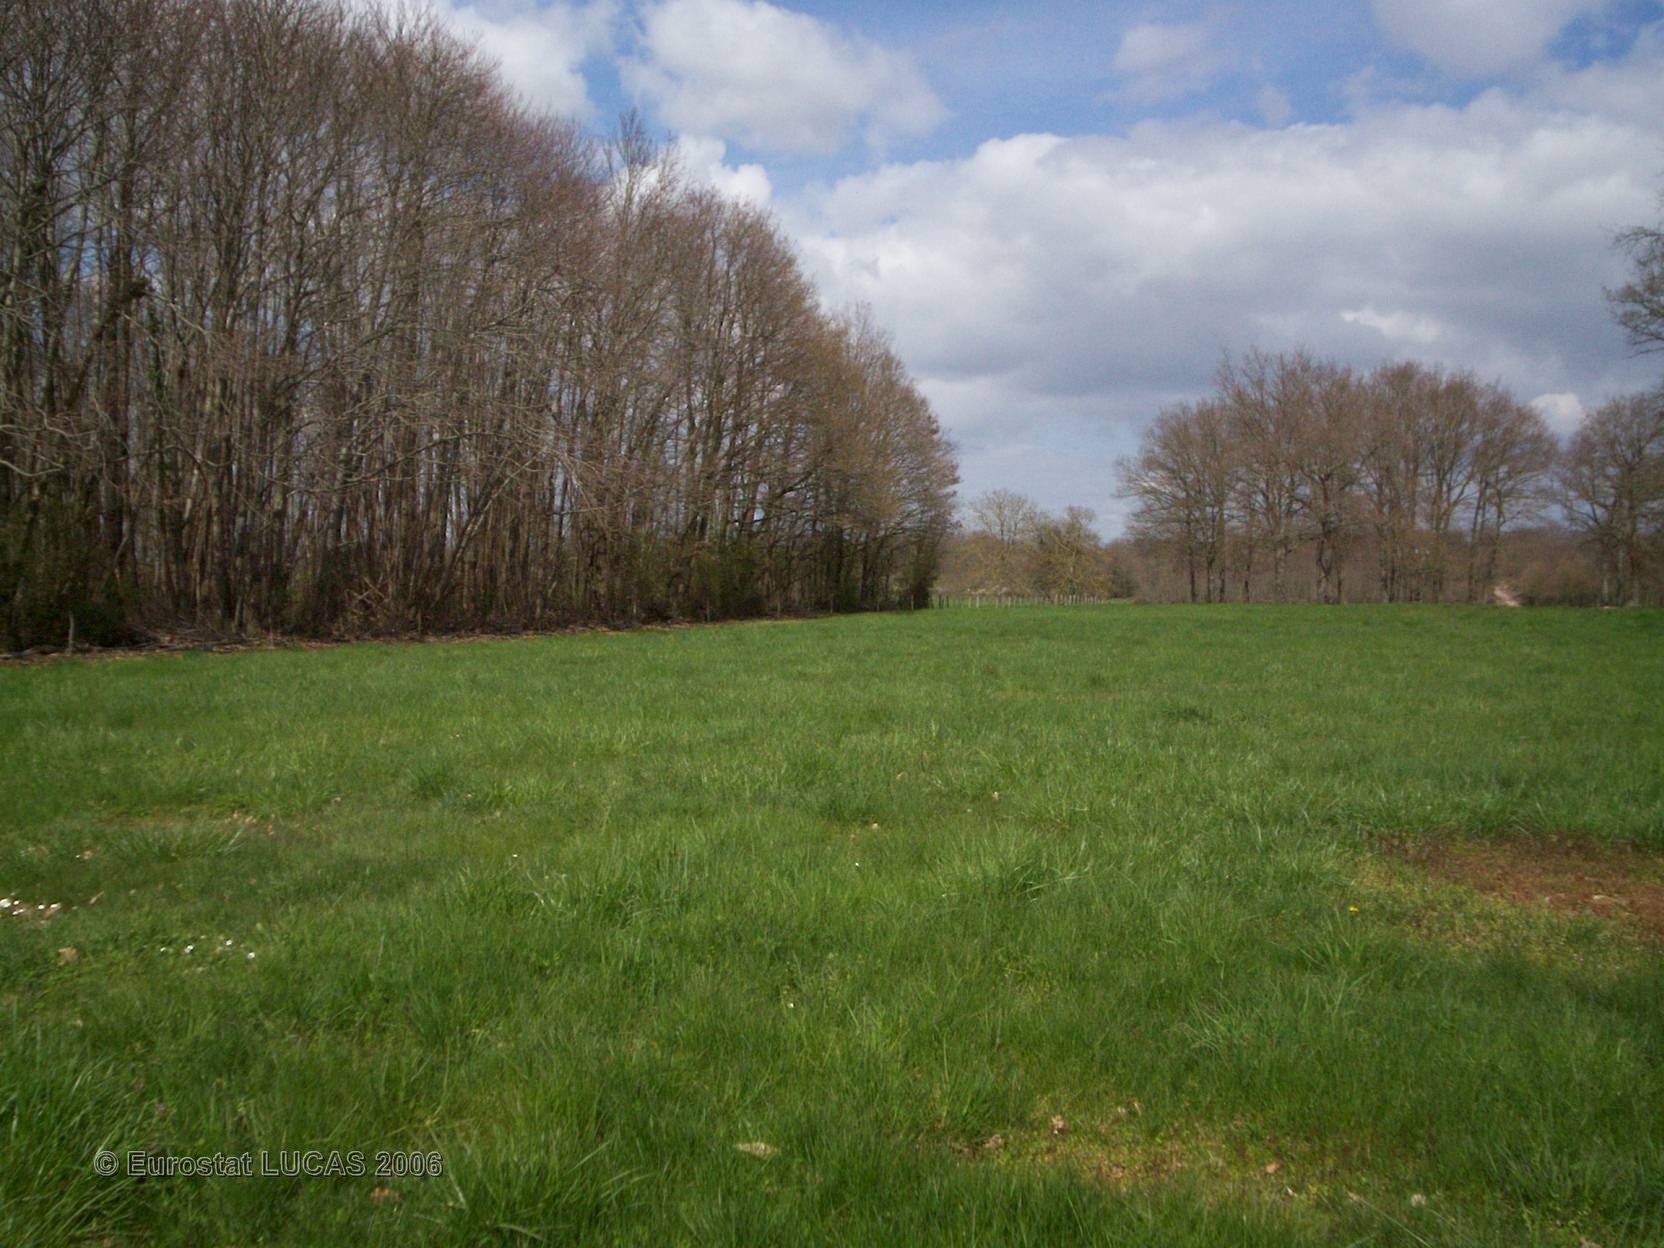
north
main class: Grassland
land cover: Grassland without tree/shrub cover
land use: Agriculture (excluding fallow land and kitchen gardens)
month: April
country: FR
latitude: 47.3676
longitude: -0.3979
